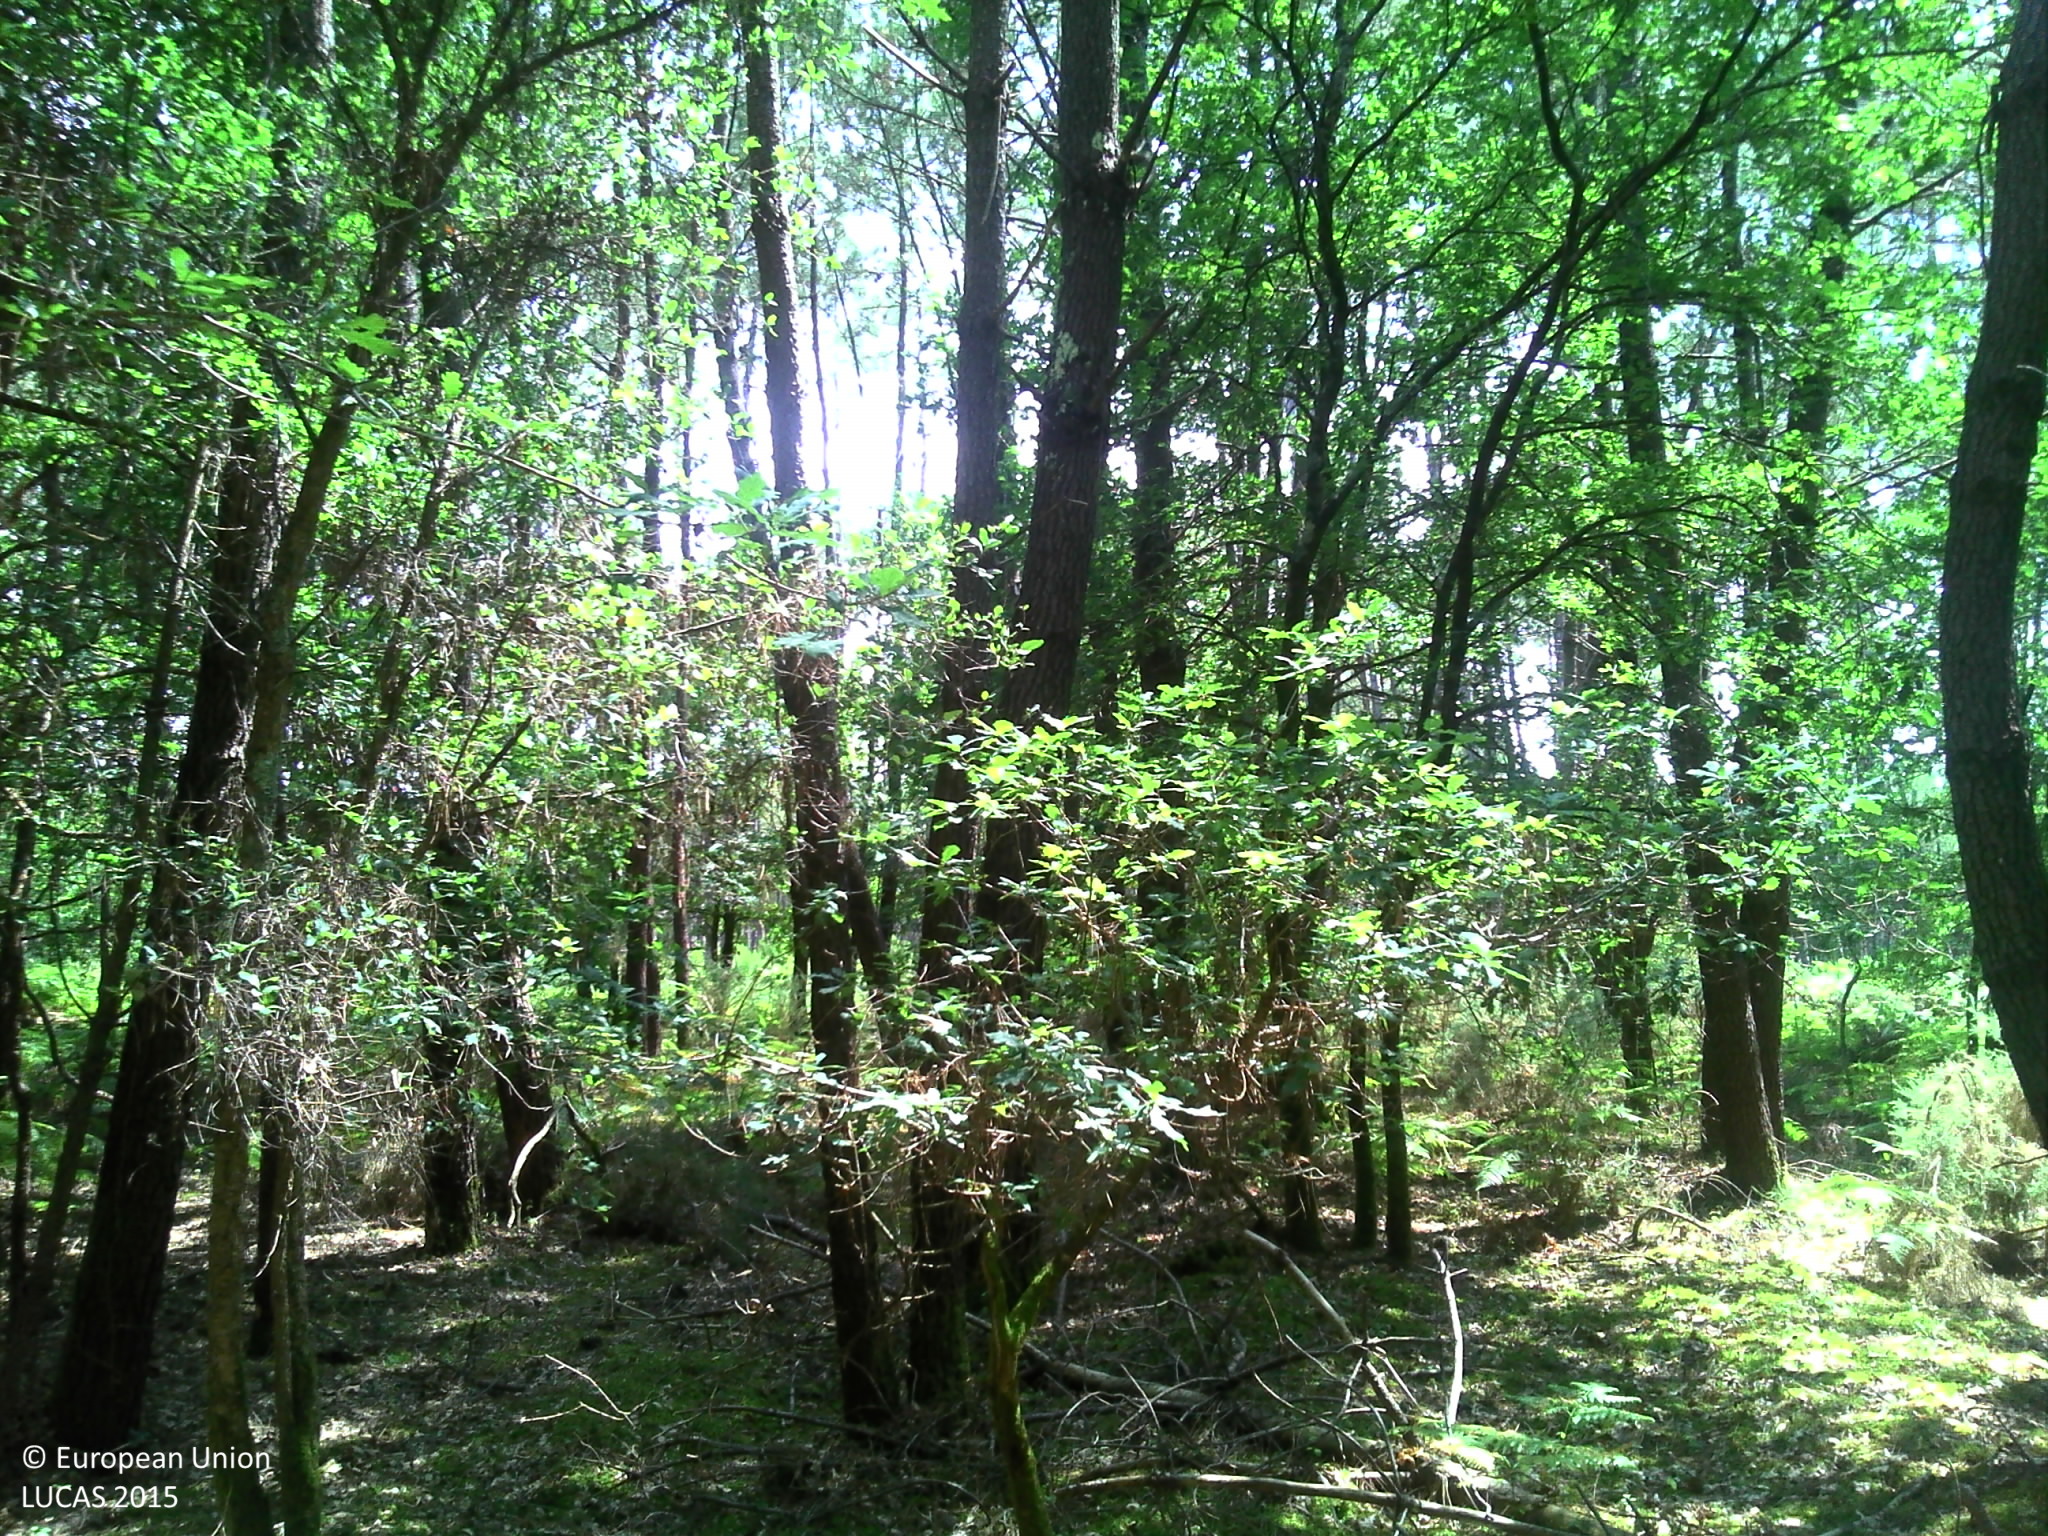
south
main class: Woodland
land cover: Pine dominated mixed woodland
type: coniferous forest of the mediterranean region
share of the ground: > 75 %
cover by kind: coniferous forest trees 50 %, broadleaved forest trees 25 %, lichens and mosses 15 %, herbaceous plants 10 %
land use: Forestry
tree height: > 5 m
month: July
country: FR
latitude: 43.8183
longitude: -1.1700
